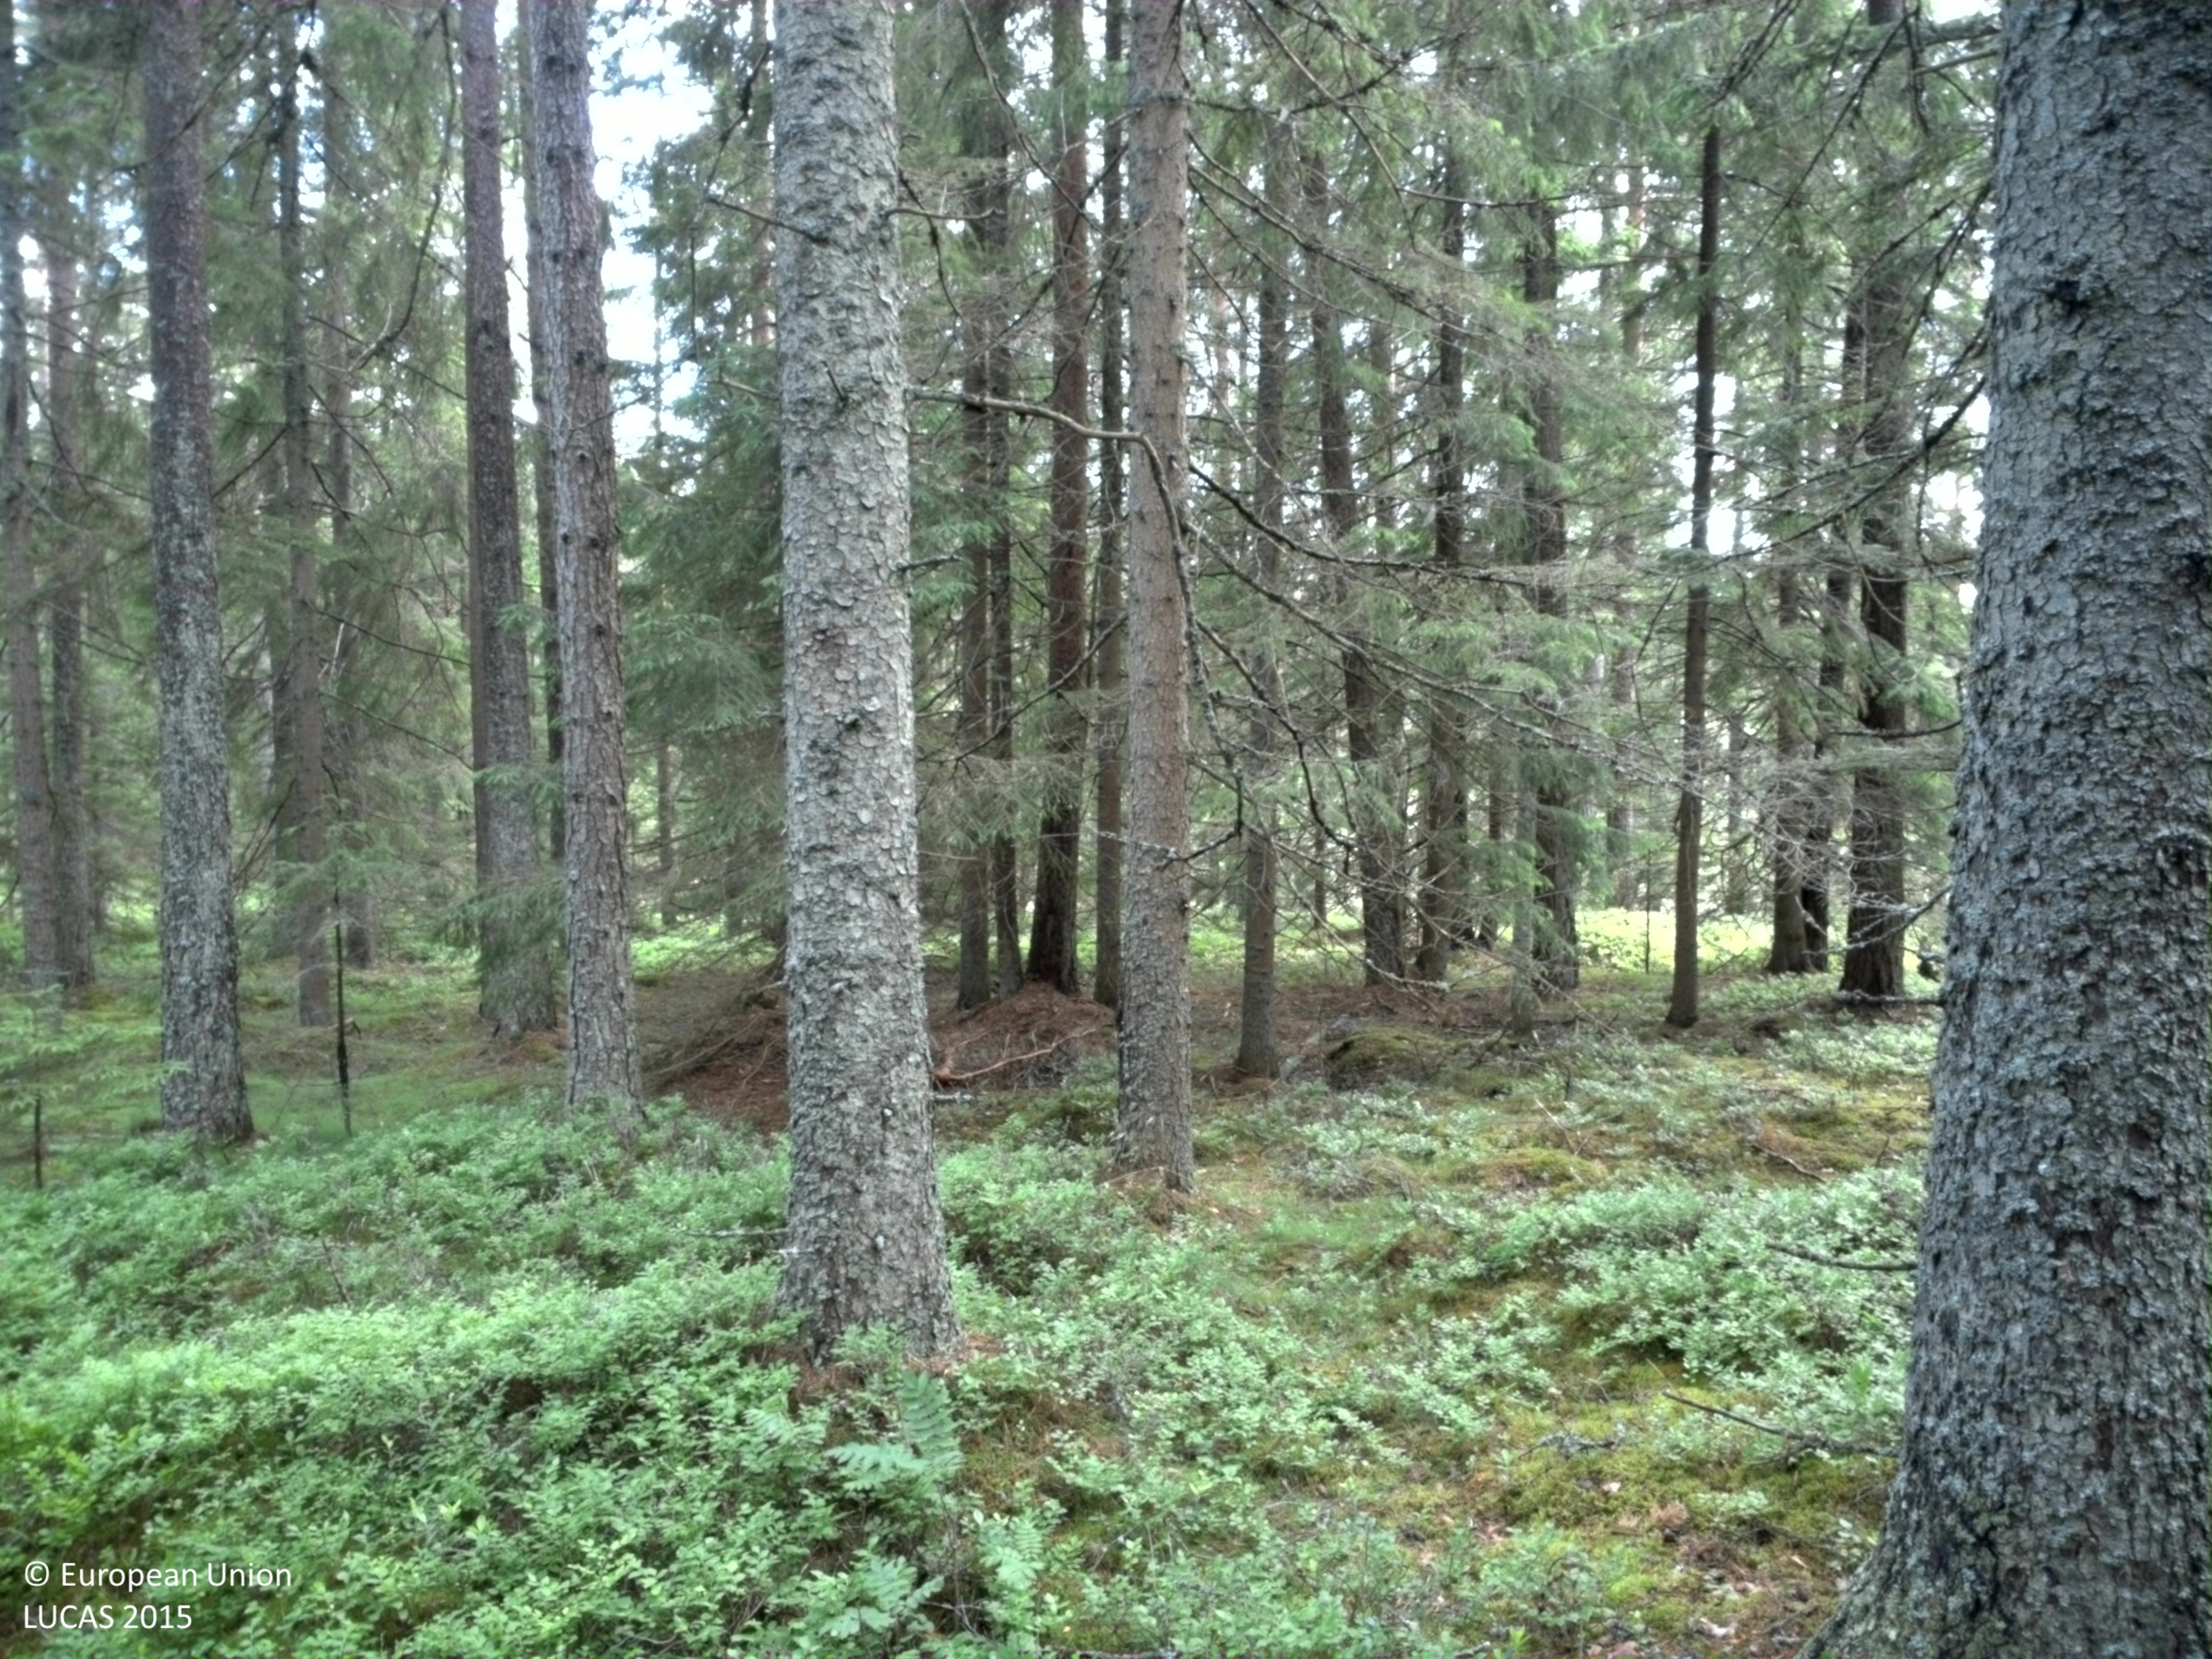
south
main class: Woodland
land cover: Other coniferous woodland
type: boreal forest
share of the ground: 50 - 75 %
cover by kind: coniferous forest trees 70 %, shrubs 15 %, lichens and mosses 15 %
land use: Forestry
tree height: > 5 m
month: July
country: SE
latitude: 58.4202
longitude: 14.3251
